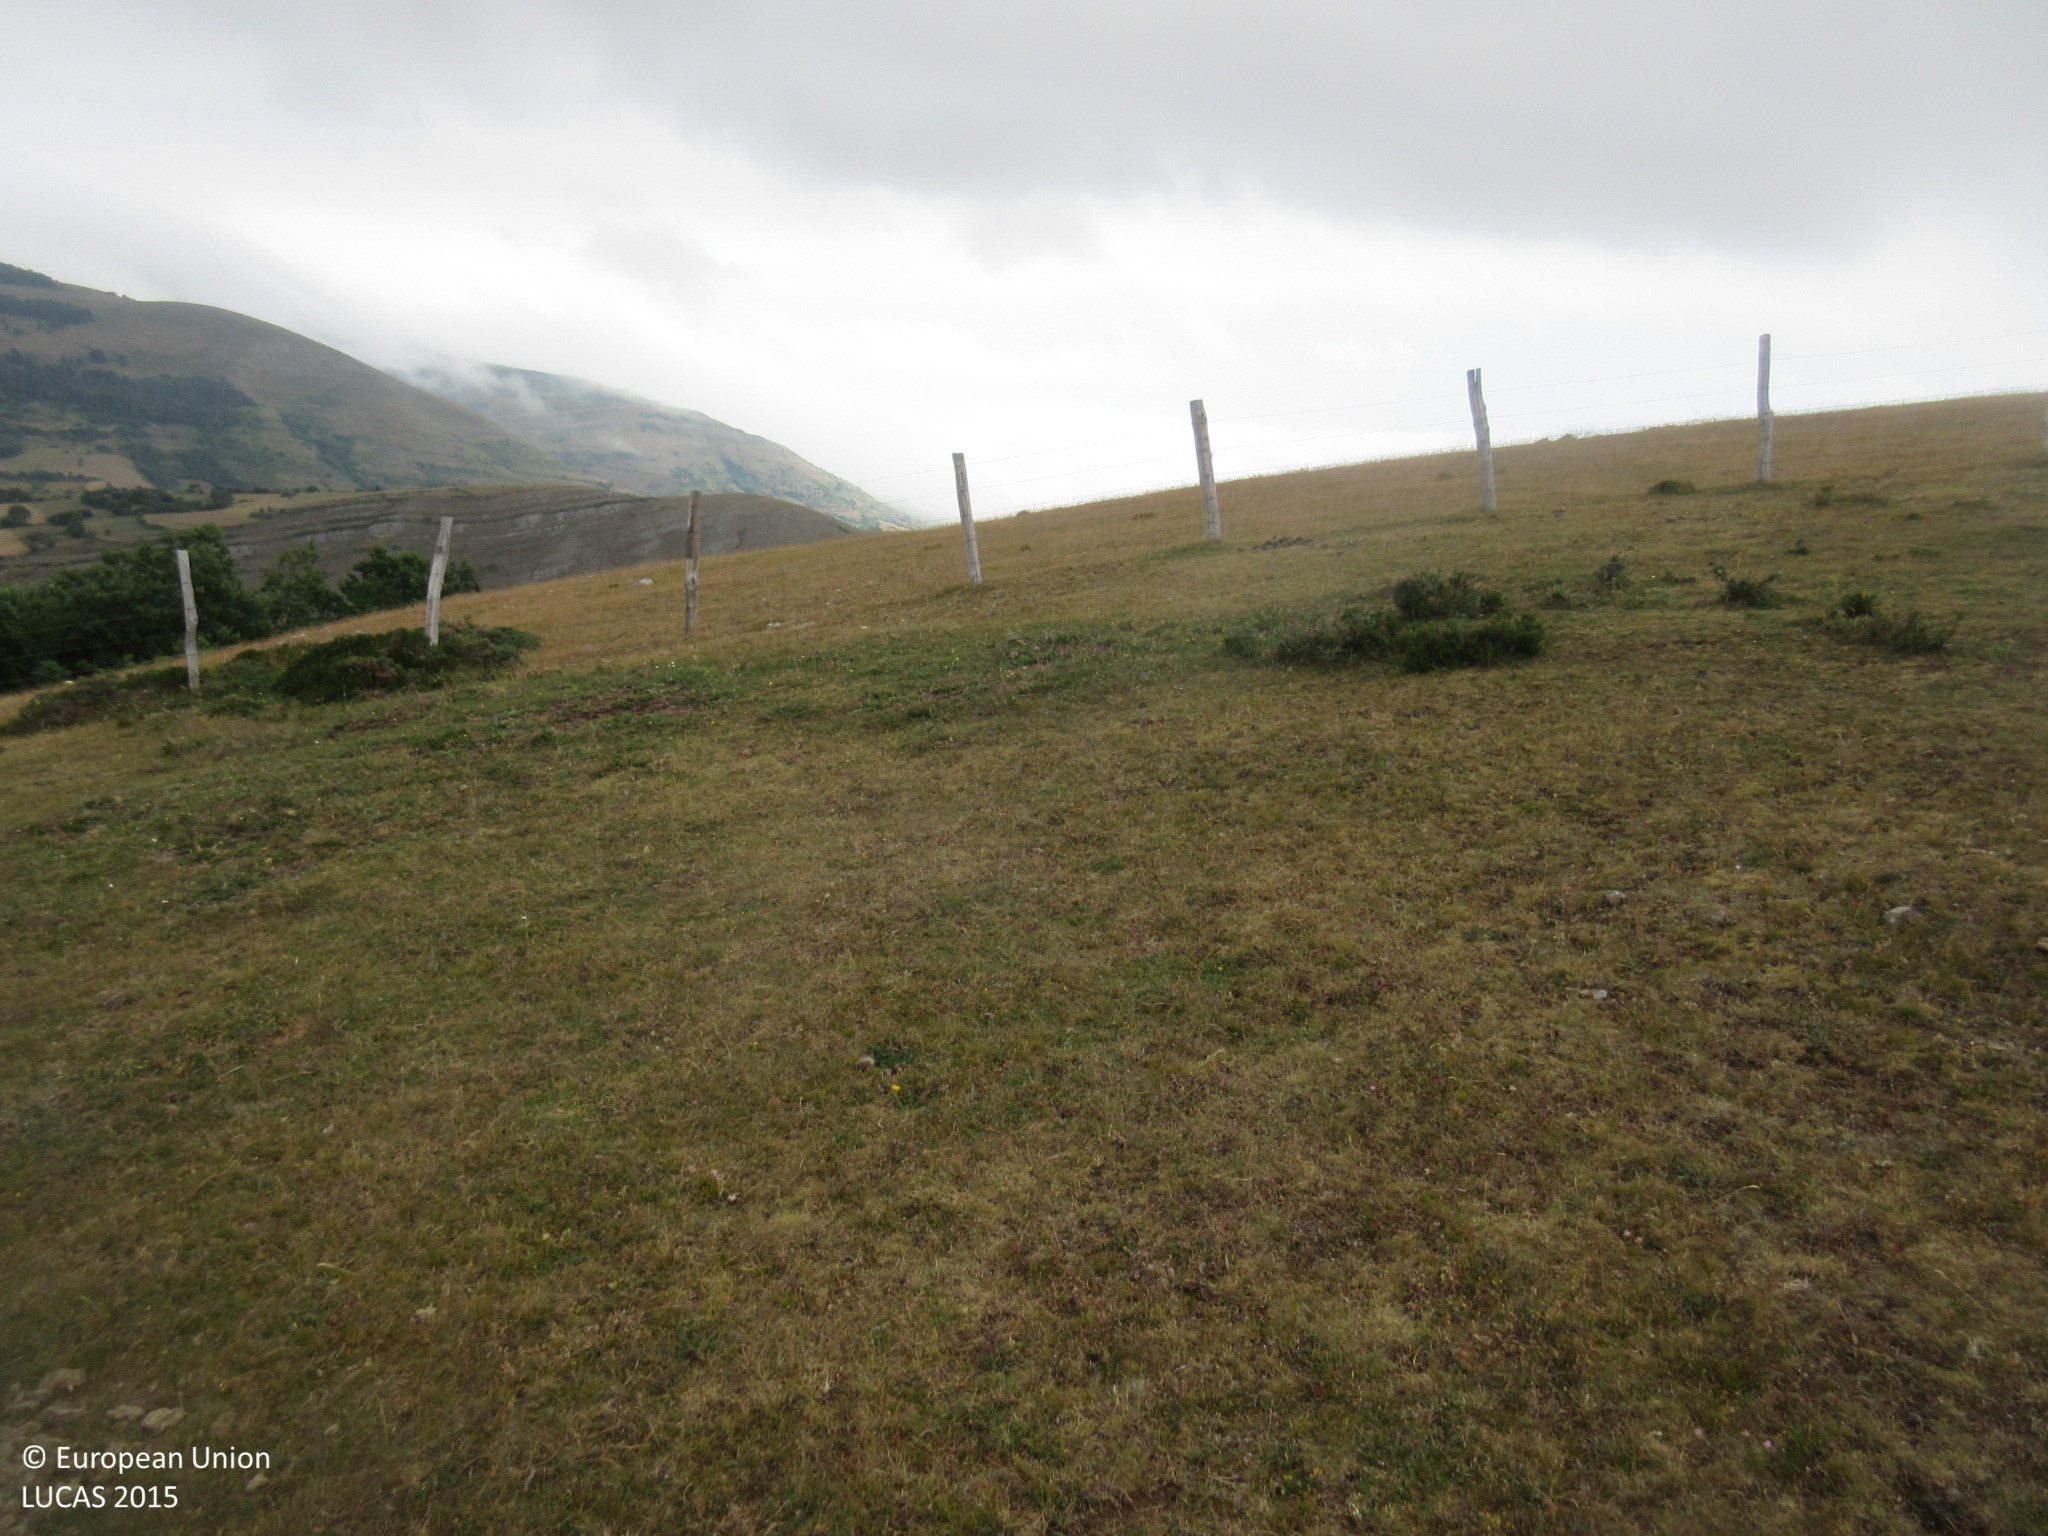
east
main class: Grassland
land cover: Grassland without tree/shrub cover
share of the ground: > 75 %
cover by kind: herbaceous plants 95 %, shrubs 5 %
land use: Agriculture (excluding fallow land and kitchen gardens)
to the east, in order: Grassland without tree/shrub cover; Fences; Grassland without tree/shrub cover; Shrubland with sparse tree cover; Broadleaved woodland
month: July
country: ES
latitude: 43.0241
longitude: -4.1755
